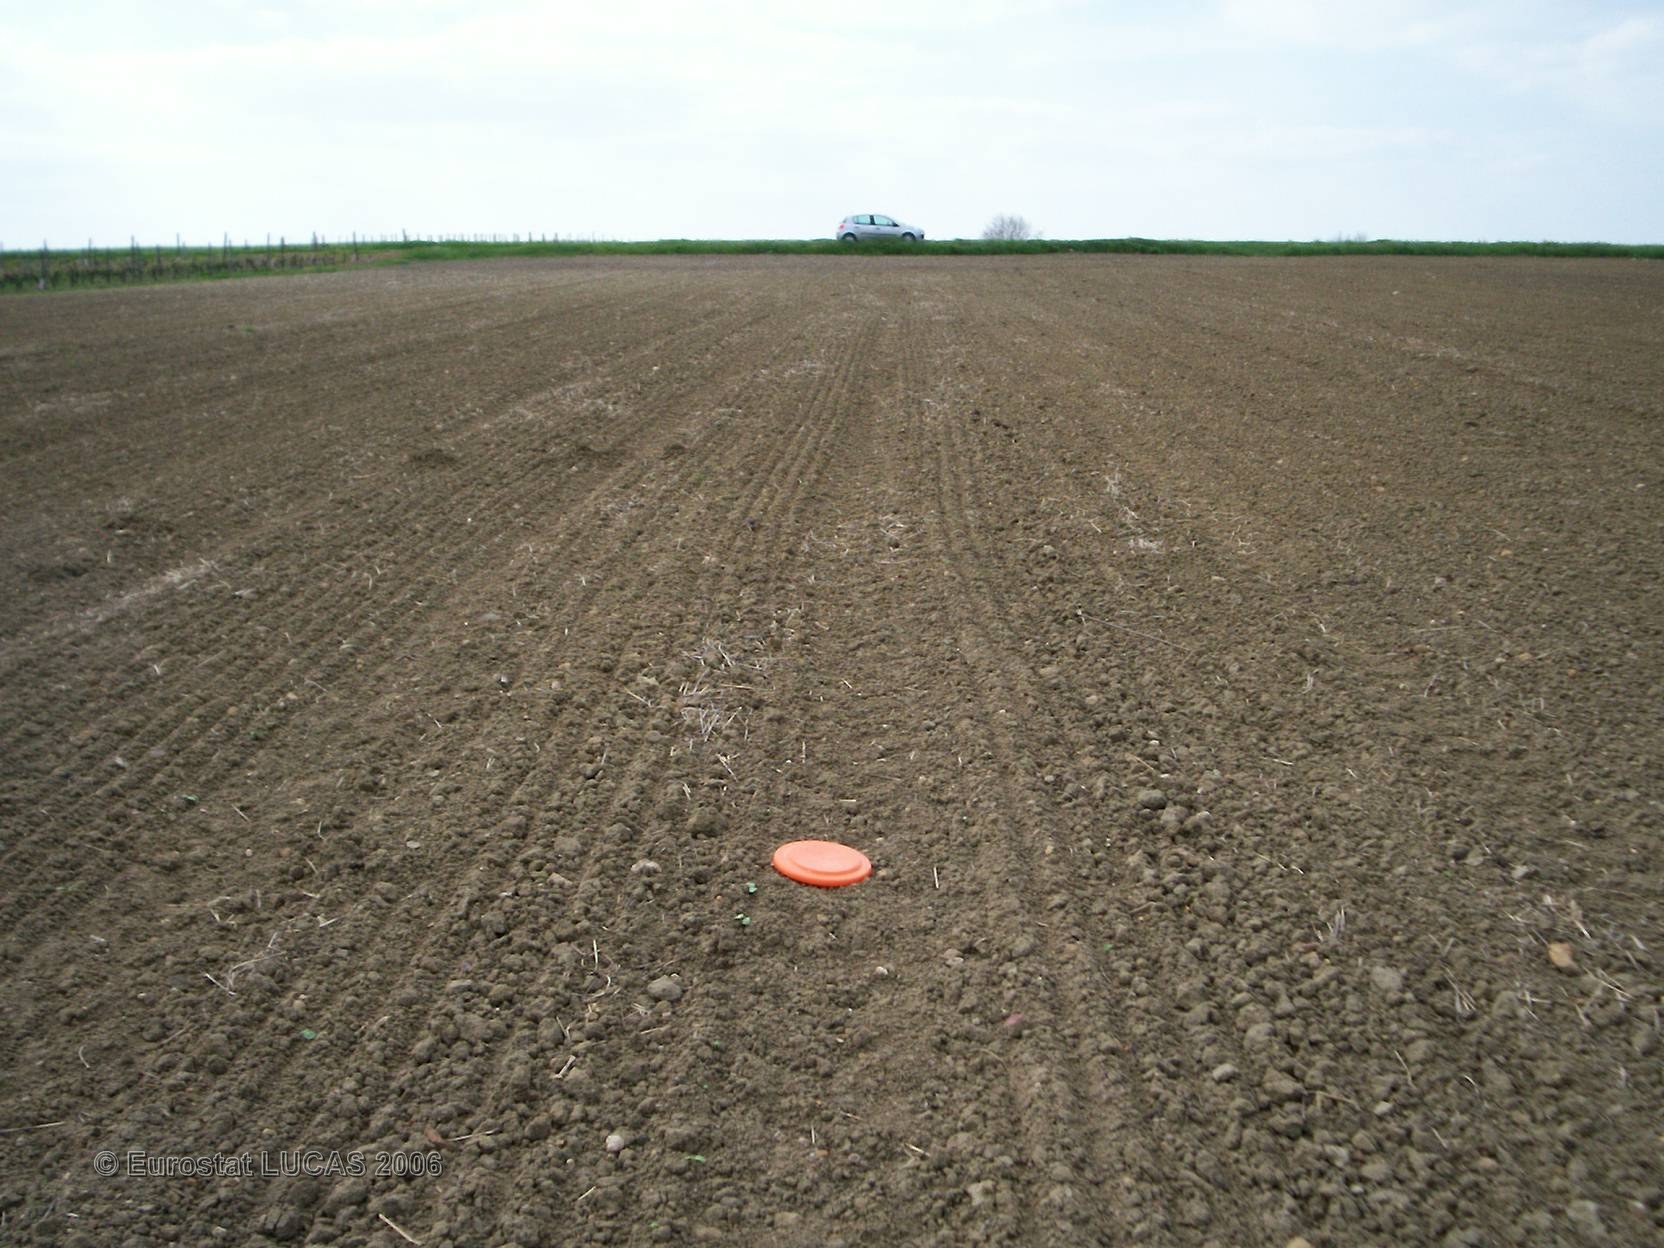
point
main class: Cropland
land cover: Sunflower
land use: Agriculture (excluding fallow land and kitchen gardens)
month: April
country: FR
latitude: 47.1257
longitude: 0.3160
